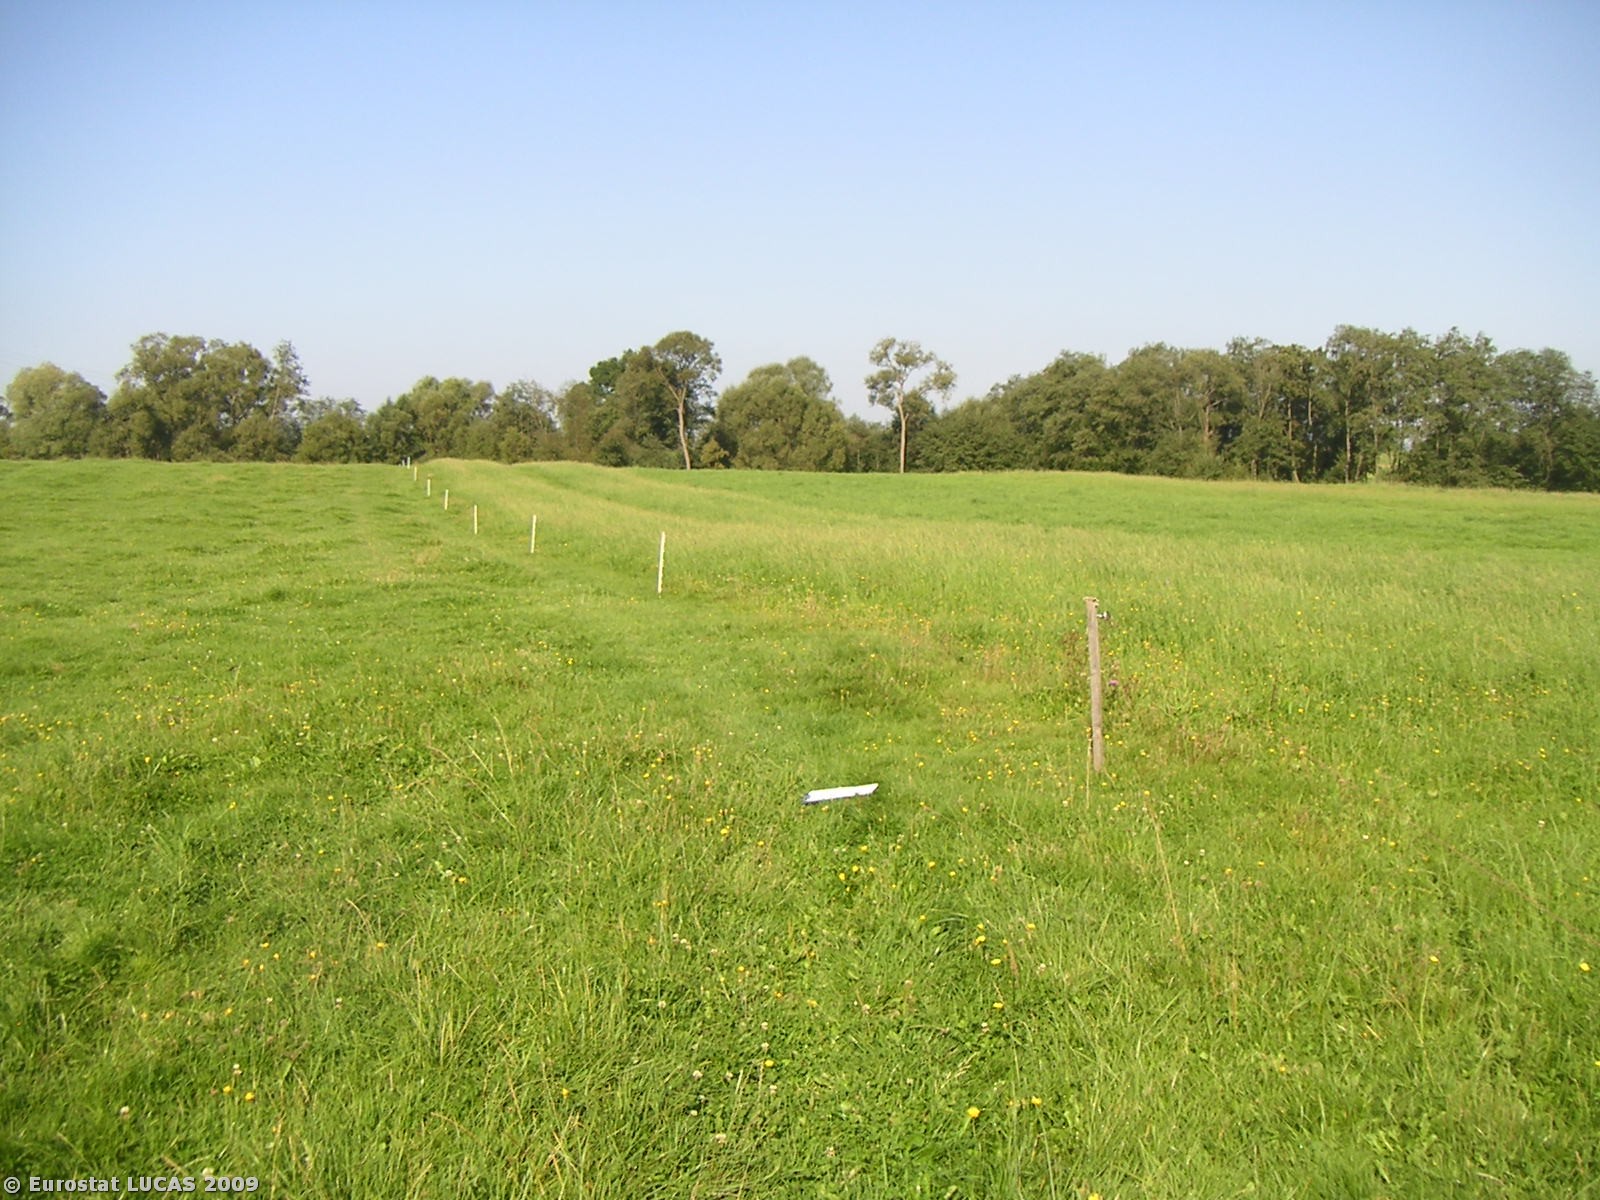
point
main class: Grassland
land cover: Grassland without tree/shrub cover
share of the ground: > 75 %
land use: Agriculture (excluding fallow land and kitchen gardens)
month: September
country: PL
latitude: 49.4457
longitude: 20.0872
